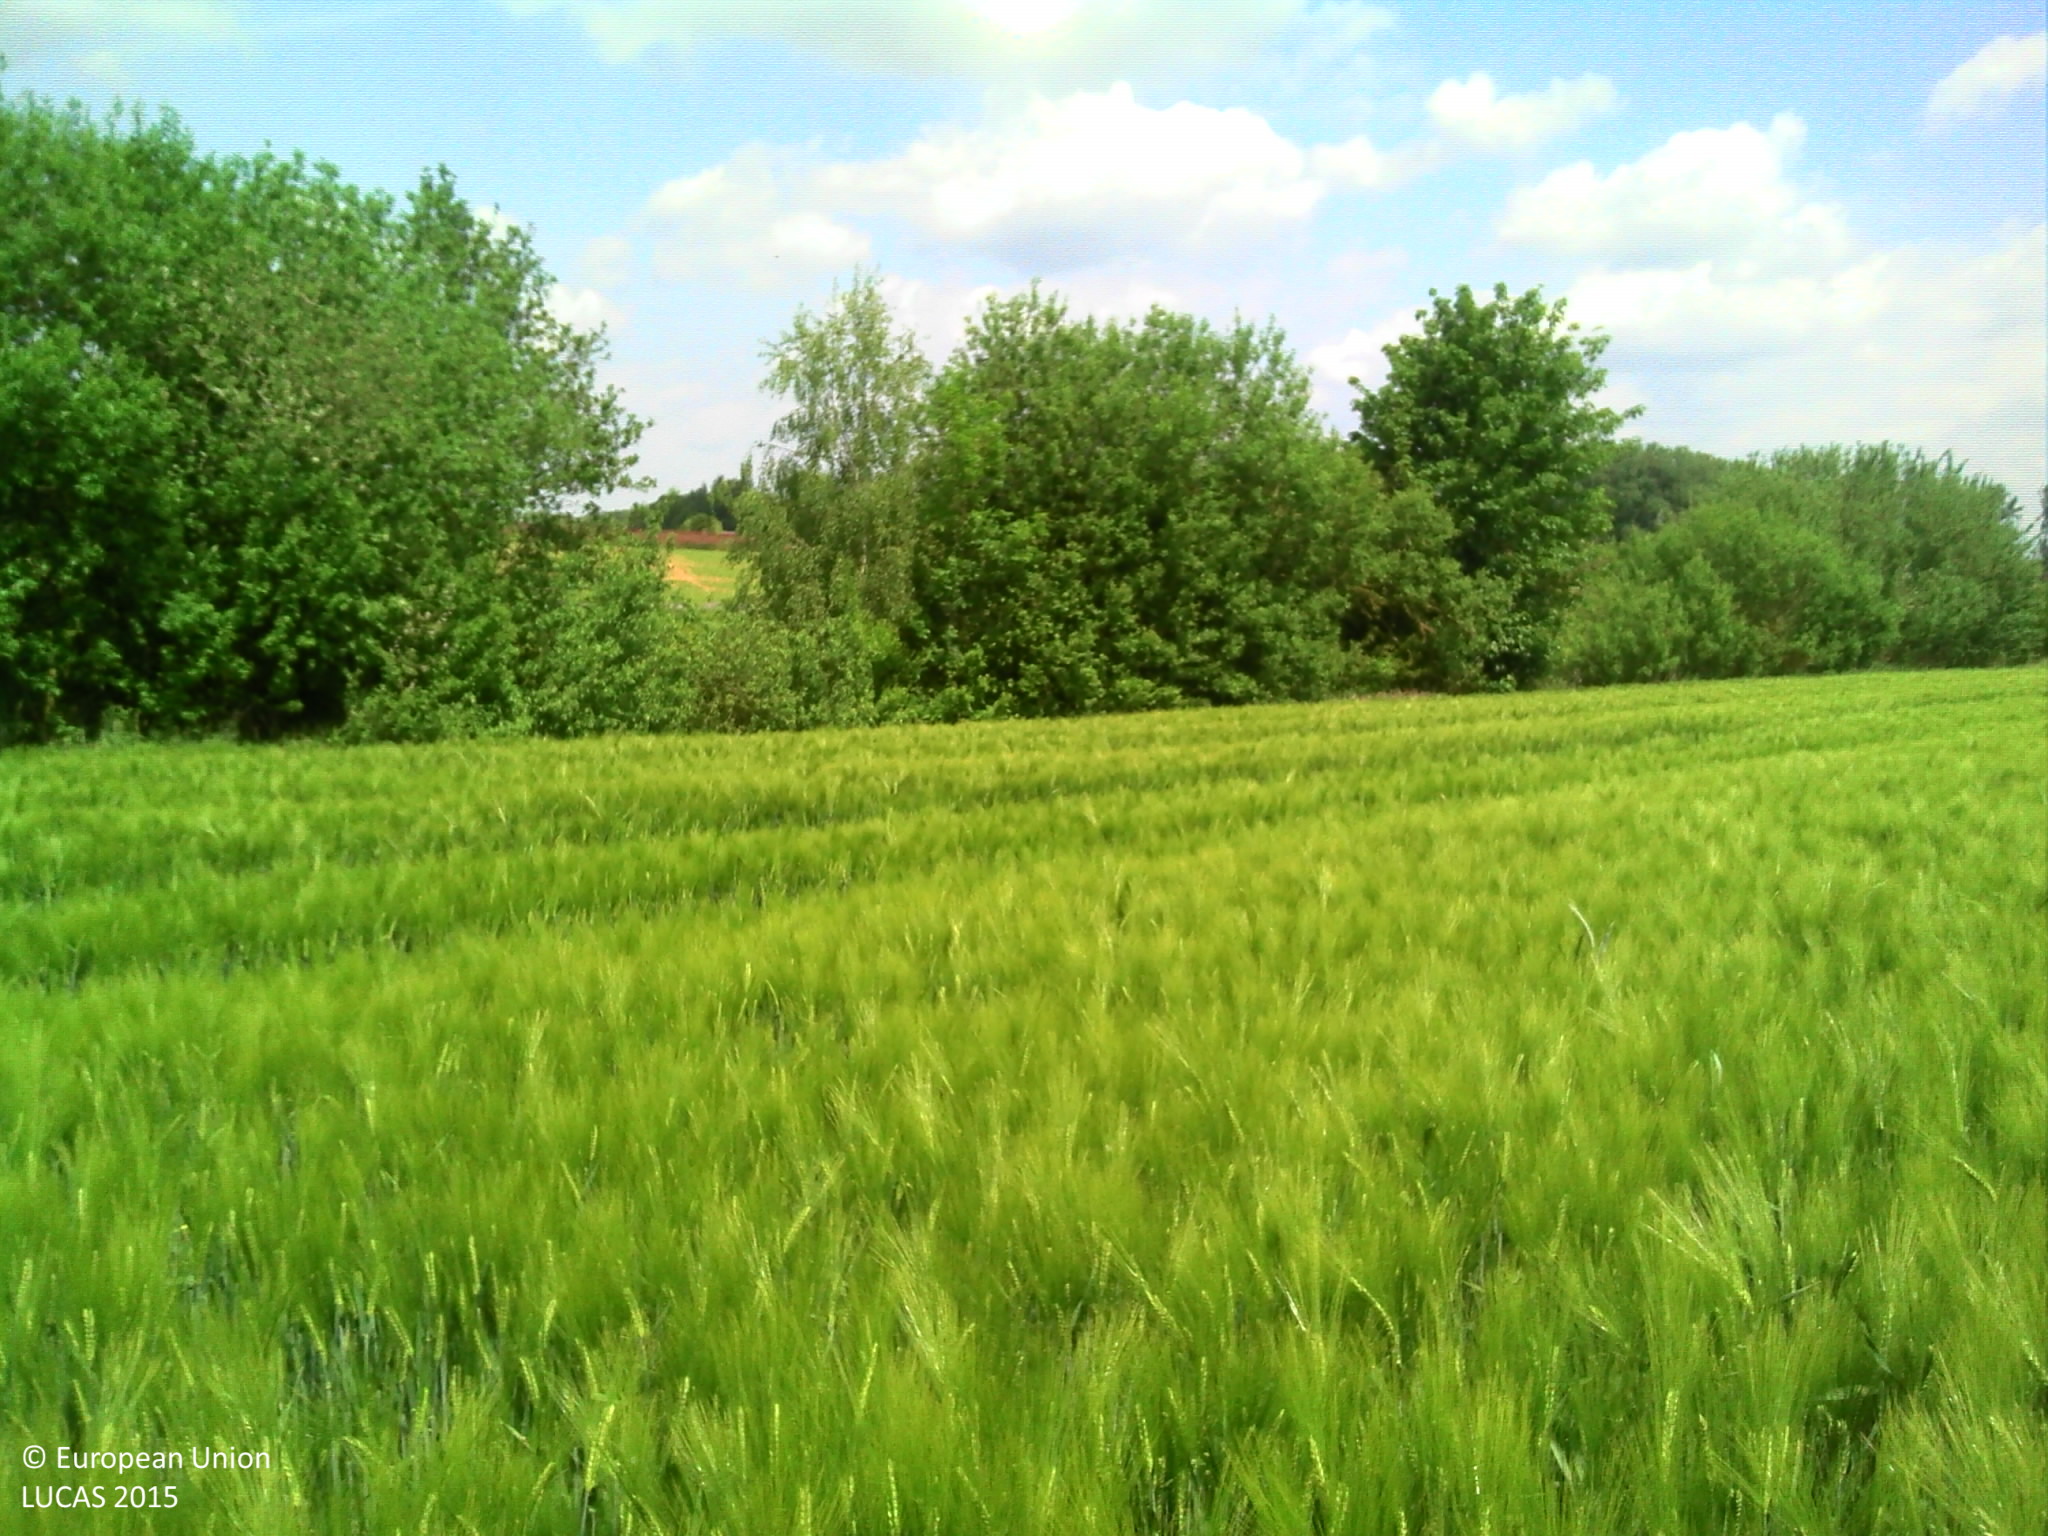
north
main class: Cropland
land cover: Barley
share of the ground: > 75 %
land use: Agriculture (excluding fallow land and kitchen gardens)
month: May
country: BE
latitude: 50.5909
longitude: 4.4726
